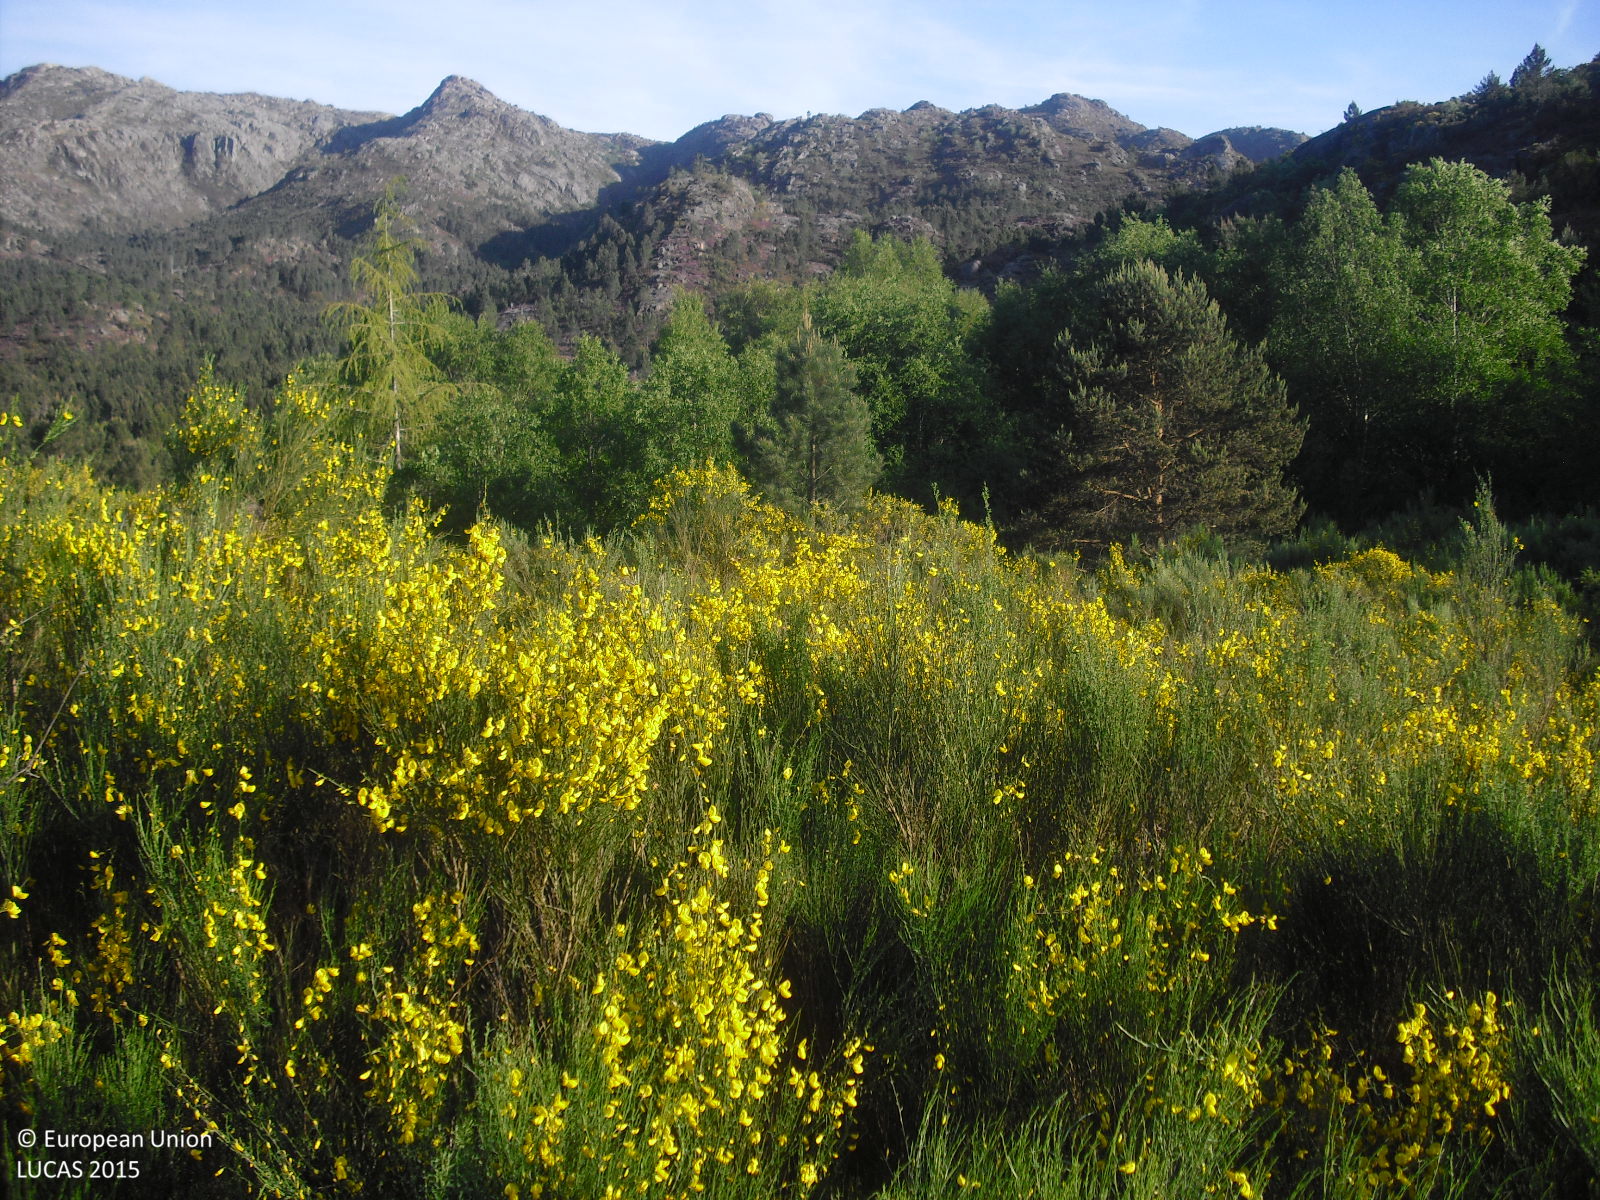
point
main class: Shrubland
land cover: Shrubland with sparse tree cover
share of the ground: > 75 %
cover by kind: shrubs 75 %, consolidated bare surface 20 %, coniferous forest trees 5 %
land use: Semi-natural and natural areas not in use
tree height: < 5 m
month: May
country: ES
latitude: 41.8373
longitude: -8.1040
